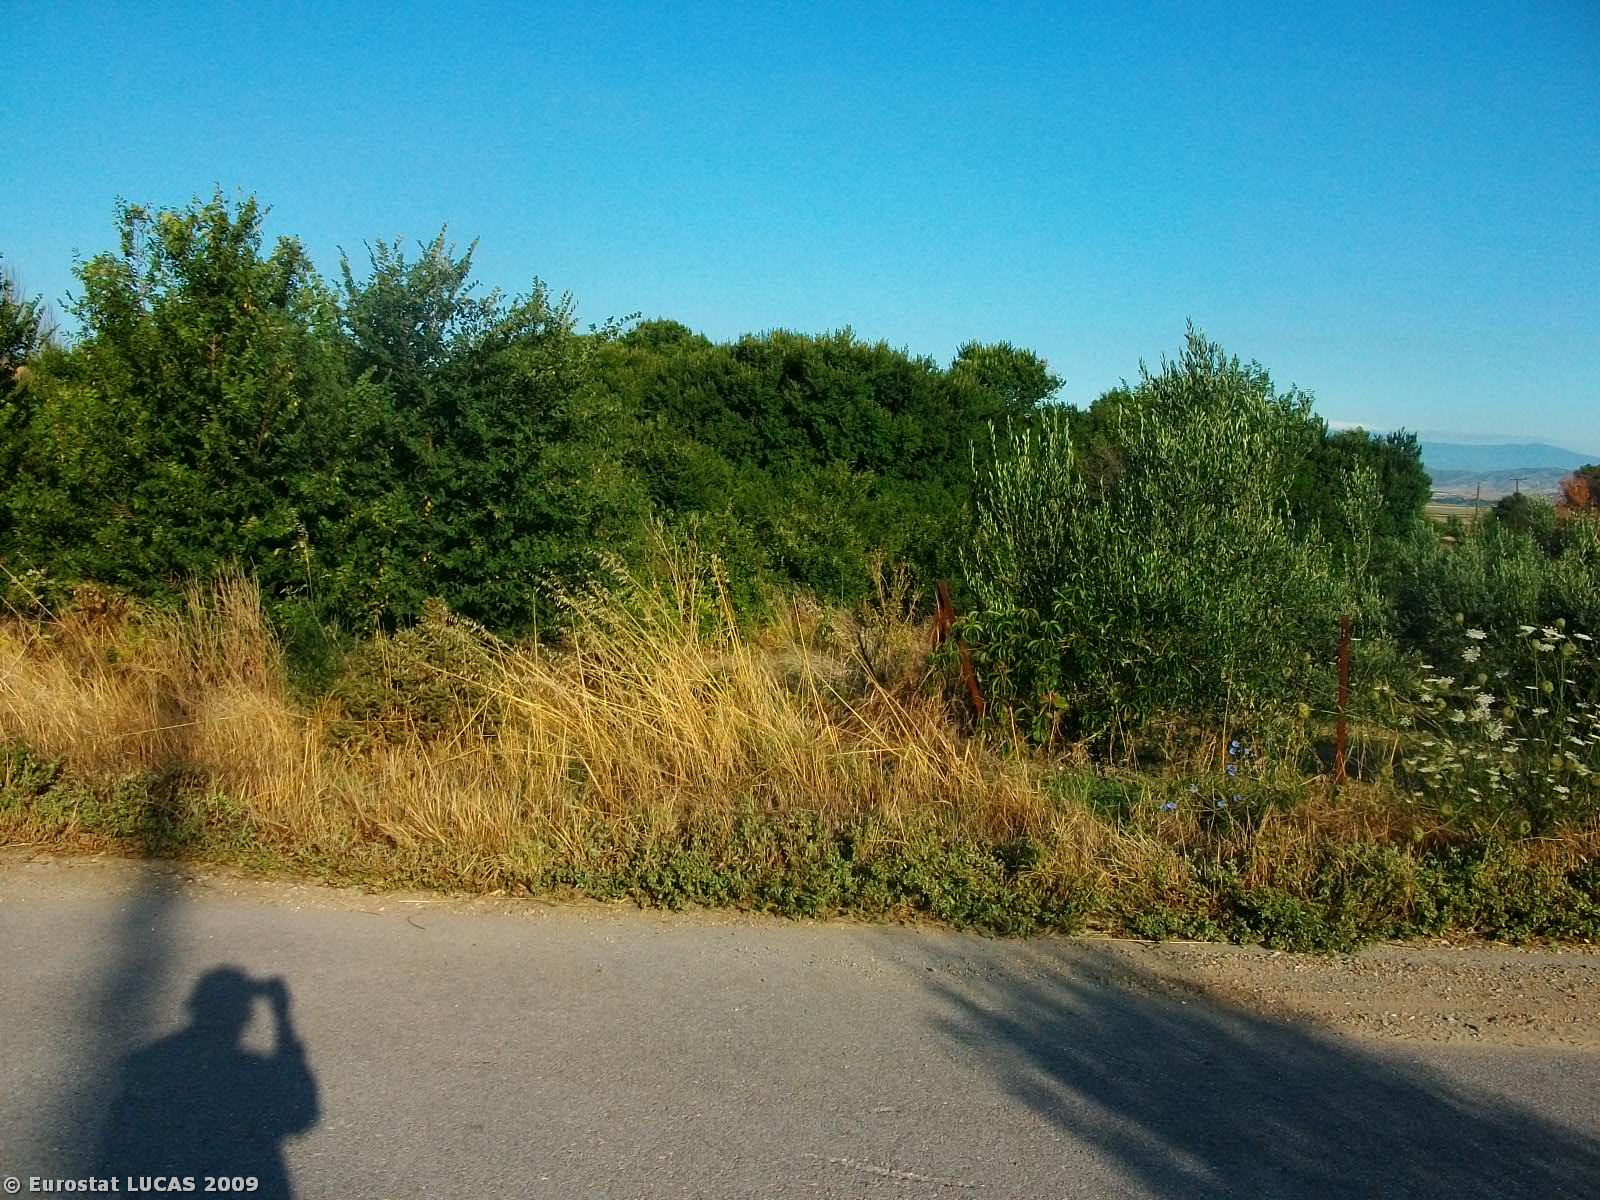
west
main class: Cropland
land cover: Vineyards
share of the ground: 50 - 75 %
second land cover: Grassland with sparse tree/shrub cover
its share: > 75 %
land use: Agriculture (excluding fallow land and kitchen gardens)
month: July
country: GR
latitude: 41.0139
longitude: 22.8166
